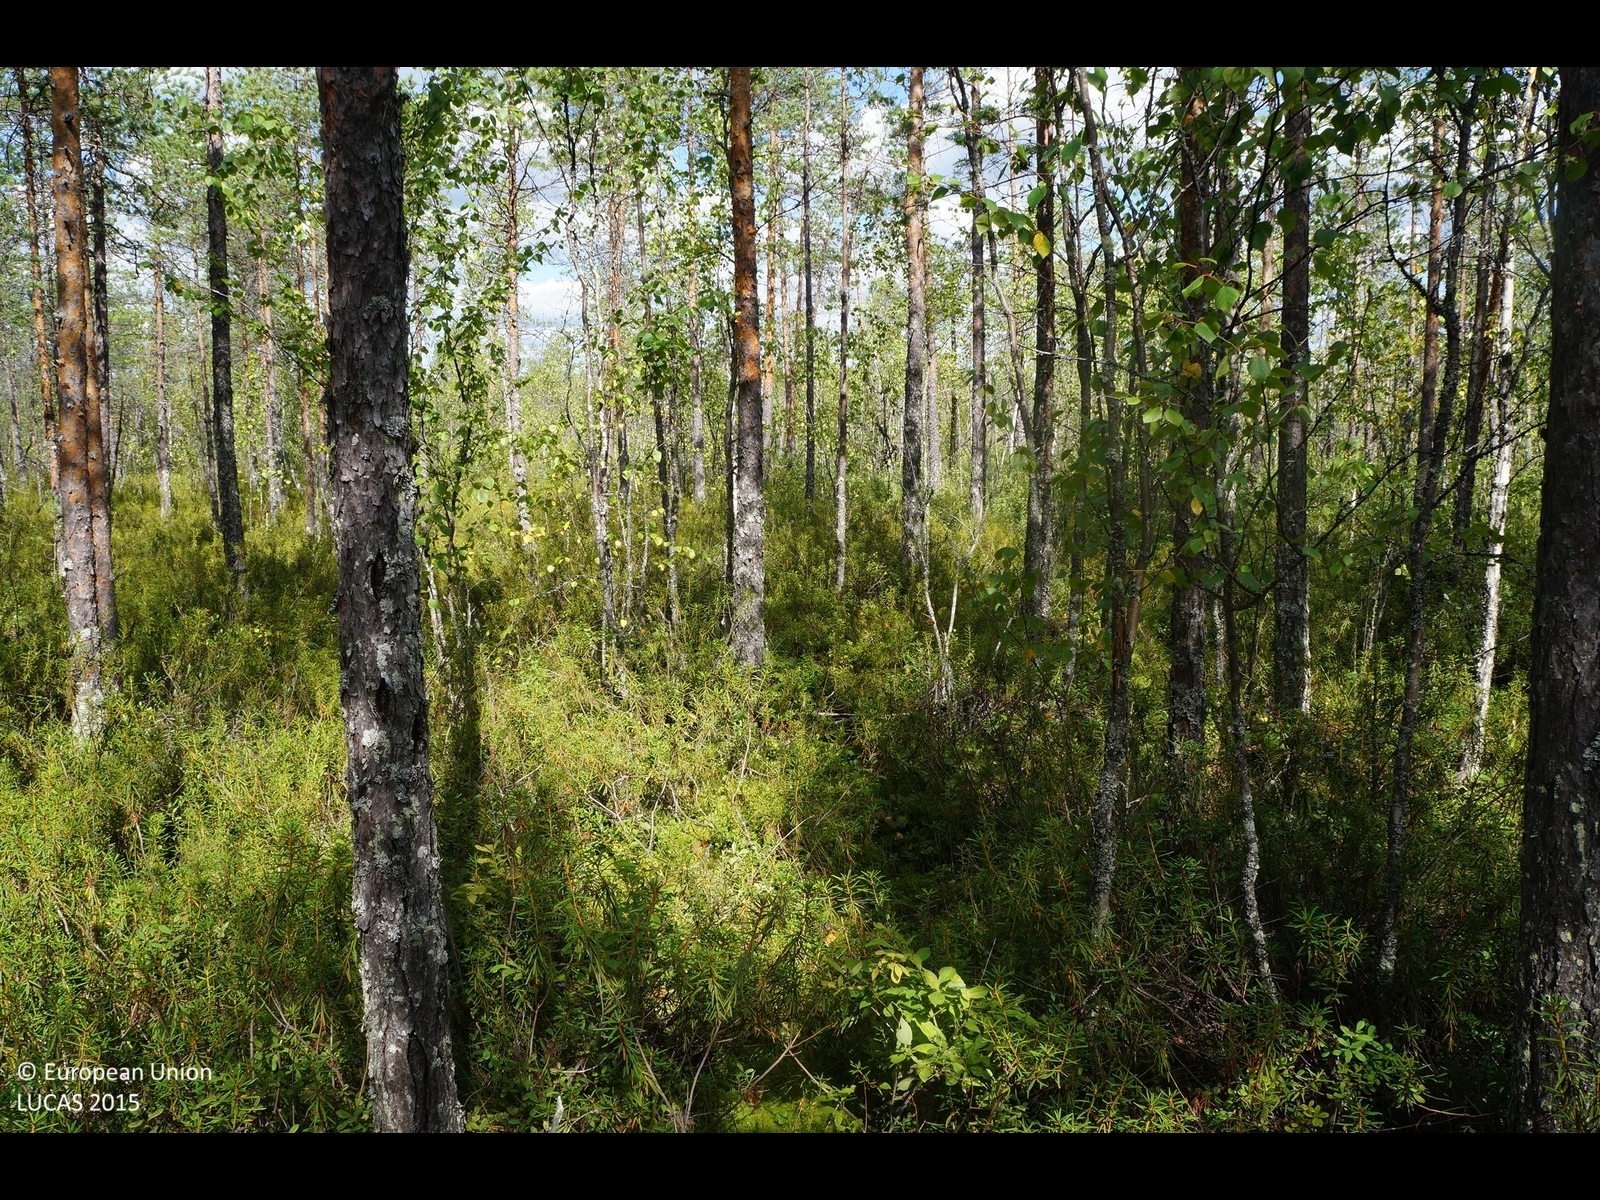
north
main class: Woodland
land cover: Pine dominated coniferous woodland
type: boreal forest
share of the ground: 25 - 50 %
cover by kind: coniferous forest trees 40 %, shrubs 40 %, lichens and mosses 15 %, broadleaved forest trees 5 %
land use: Forestry
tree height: > 5 m
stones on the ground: < 10 %
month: August
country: FI
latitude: 64.4446
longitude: 26.0389
